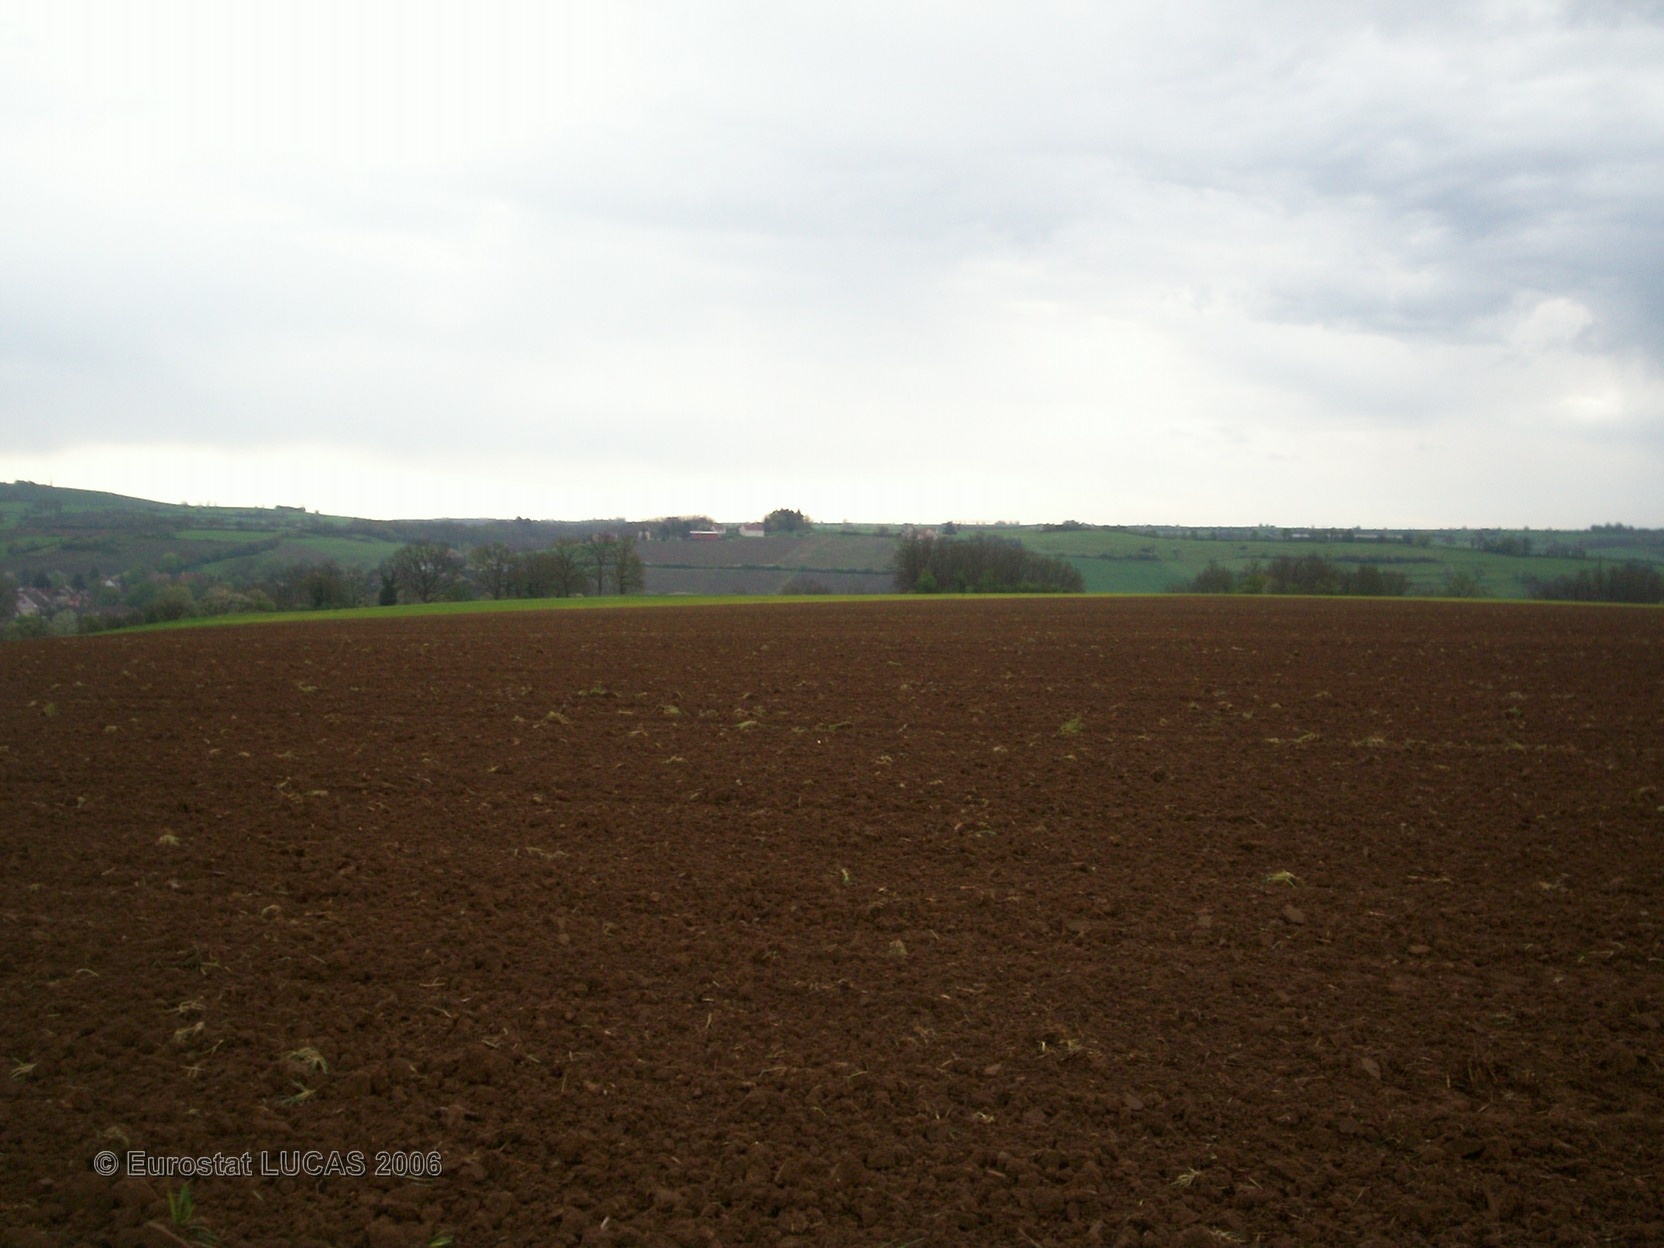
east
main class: Cropland
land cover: Sunflower
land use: Agriculture (excluding fallow land and kitchen gardens)
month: May
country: FR
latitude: 46.8663
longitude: 4.6353
